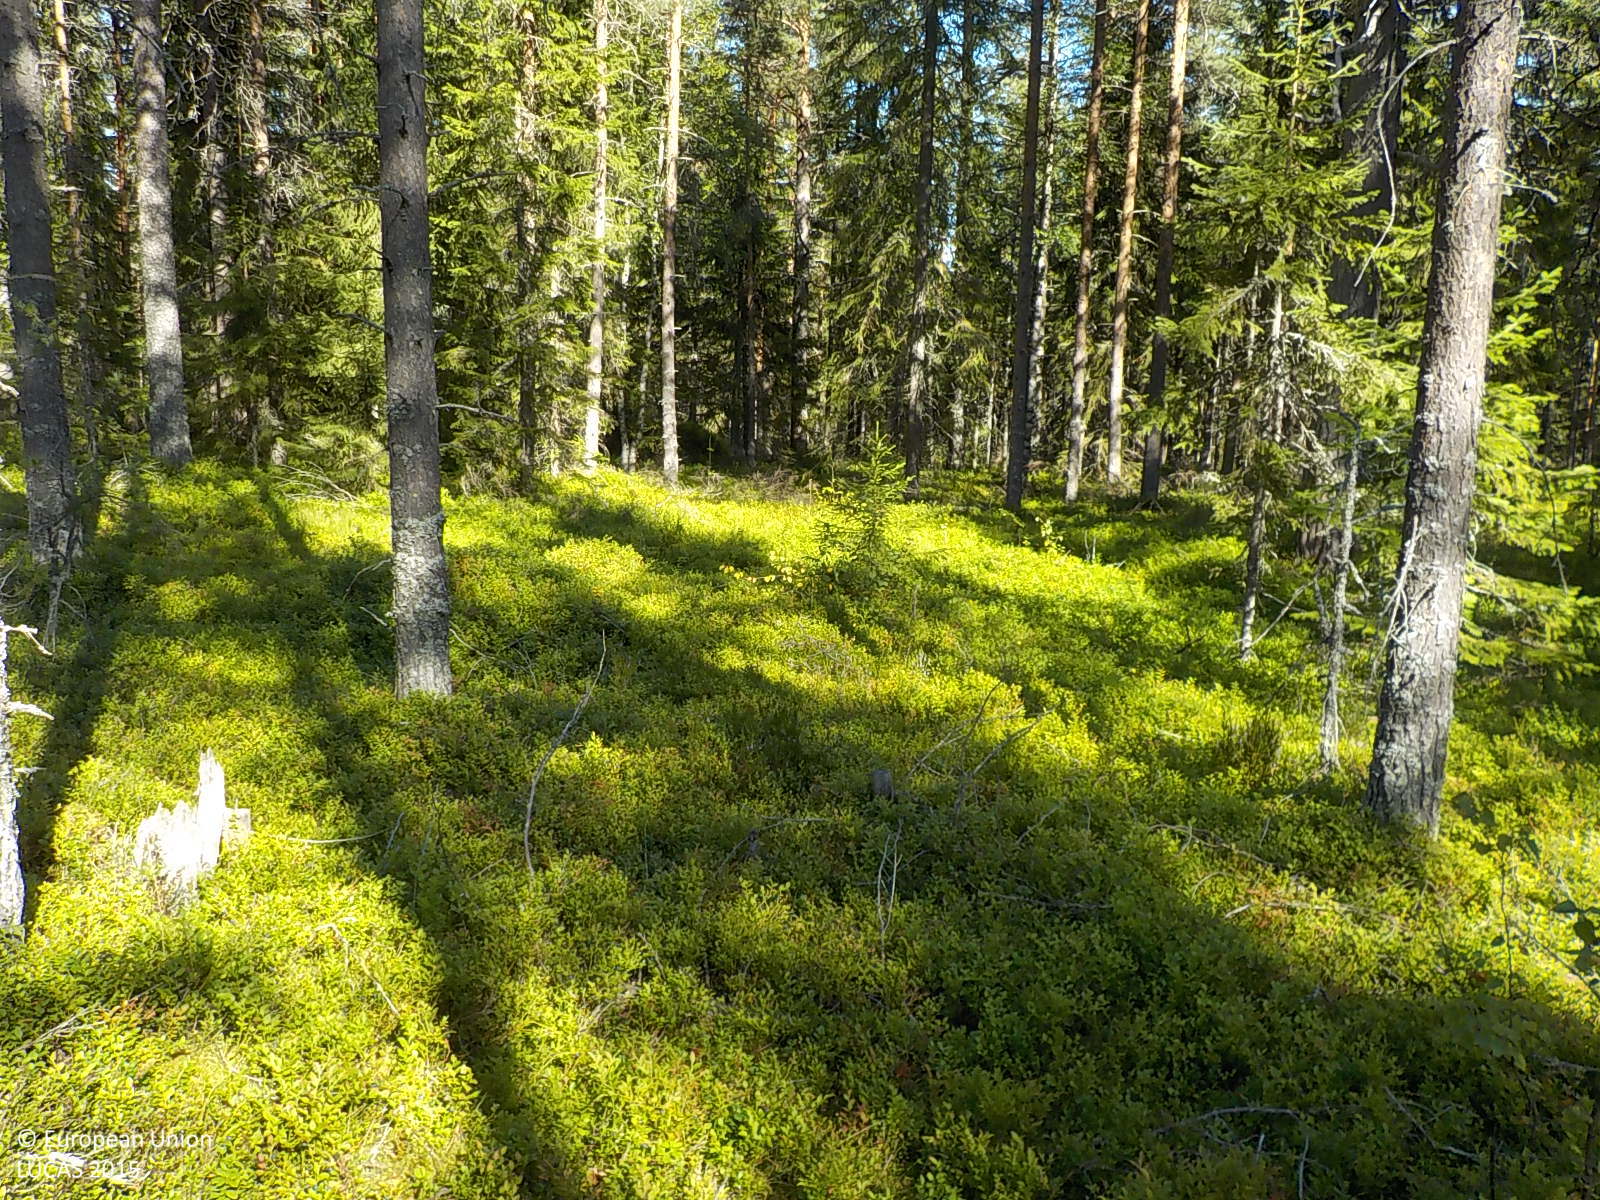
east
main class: Woodland
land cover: Pine dominated coniferous woodland
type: boreal forest
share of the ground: 50 - 75 %
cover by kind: coniferous forest trees 70 %, shrubs 30 %
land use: Forestry
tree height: > 5 m
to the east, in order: Pine dominated coniferous woodland; Pine dominated mixed woodland; Spruce dominated mixed woodland; Tracks; Spruce dominated mixed woodland; Tracks; Electric lines; Spruce dominated coniferous woodland
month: August
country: SE
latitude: 63.1687
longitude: 18.5374
